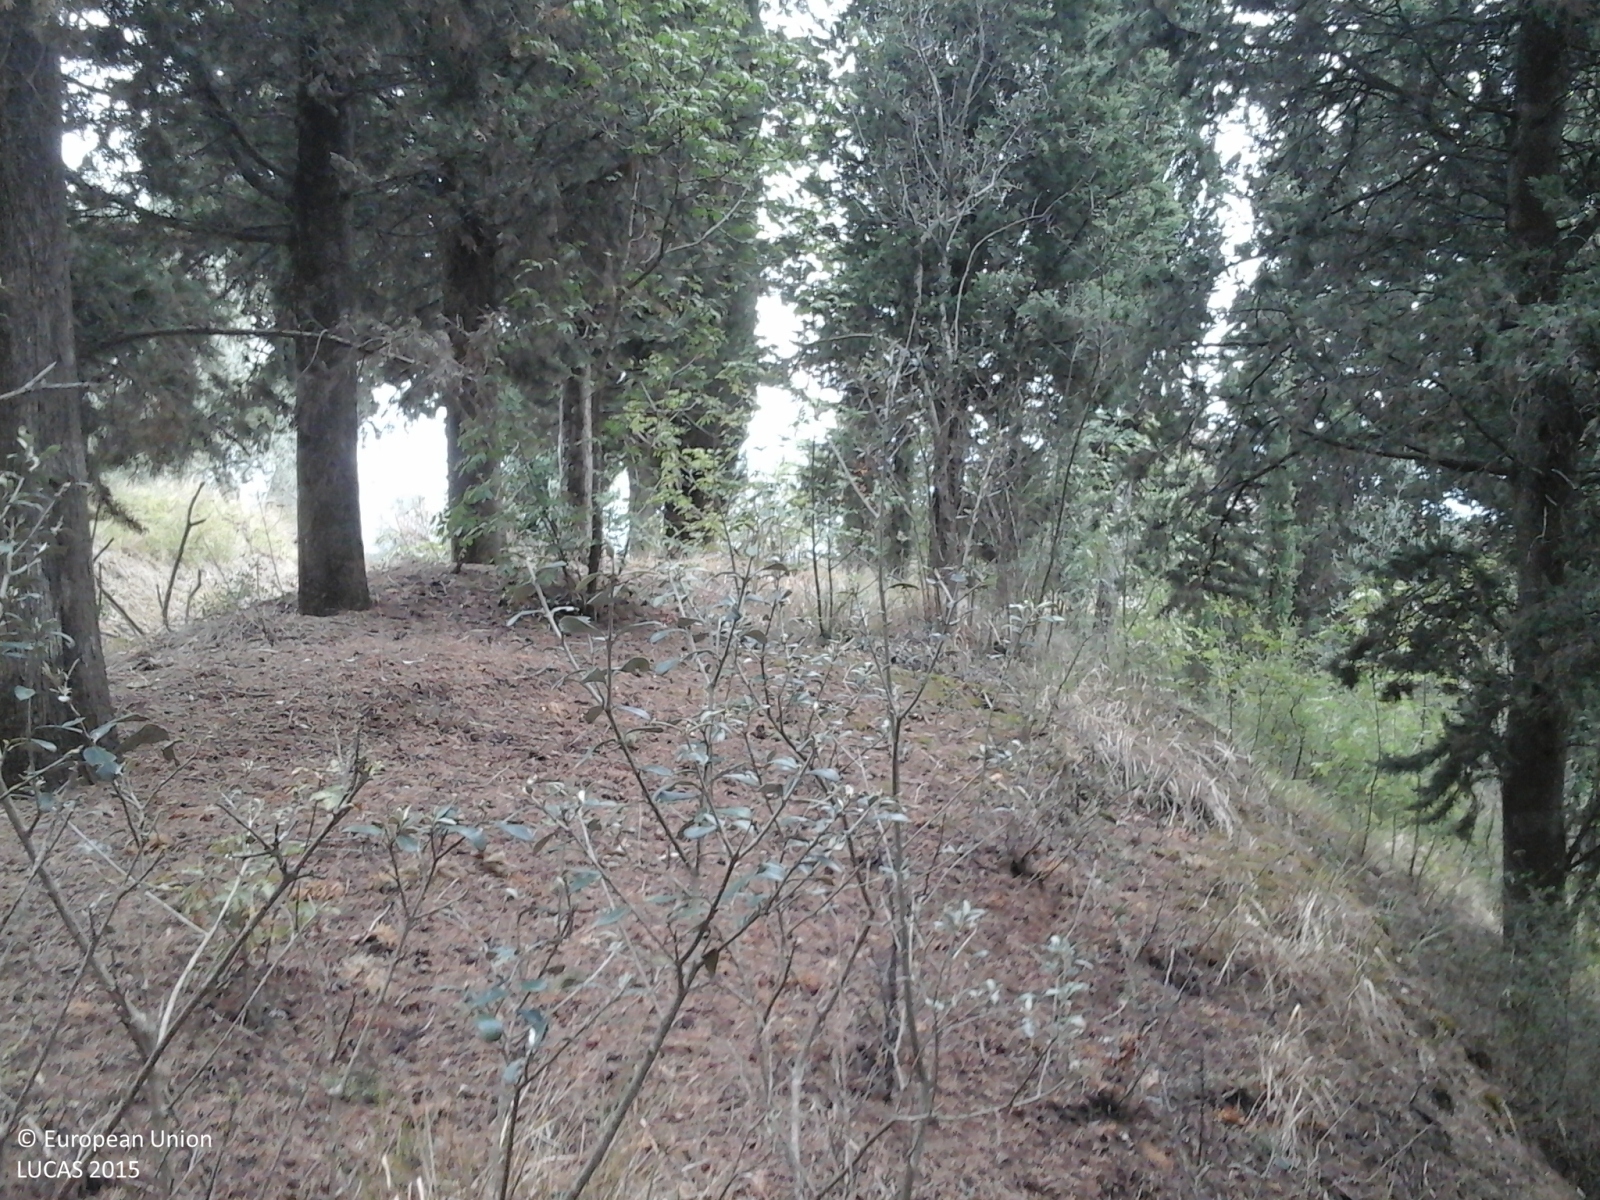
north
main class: Woodland
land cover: Other mixed woodland
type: mesophytic deciduous forest
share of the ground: > 75 %
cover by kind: broadleaved forest trees 75 %, coniferous forest trees 25 %
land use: Forestry
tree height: > 5 m
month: July
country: IT
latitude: 43.5872
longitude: 11.0746
